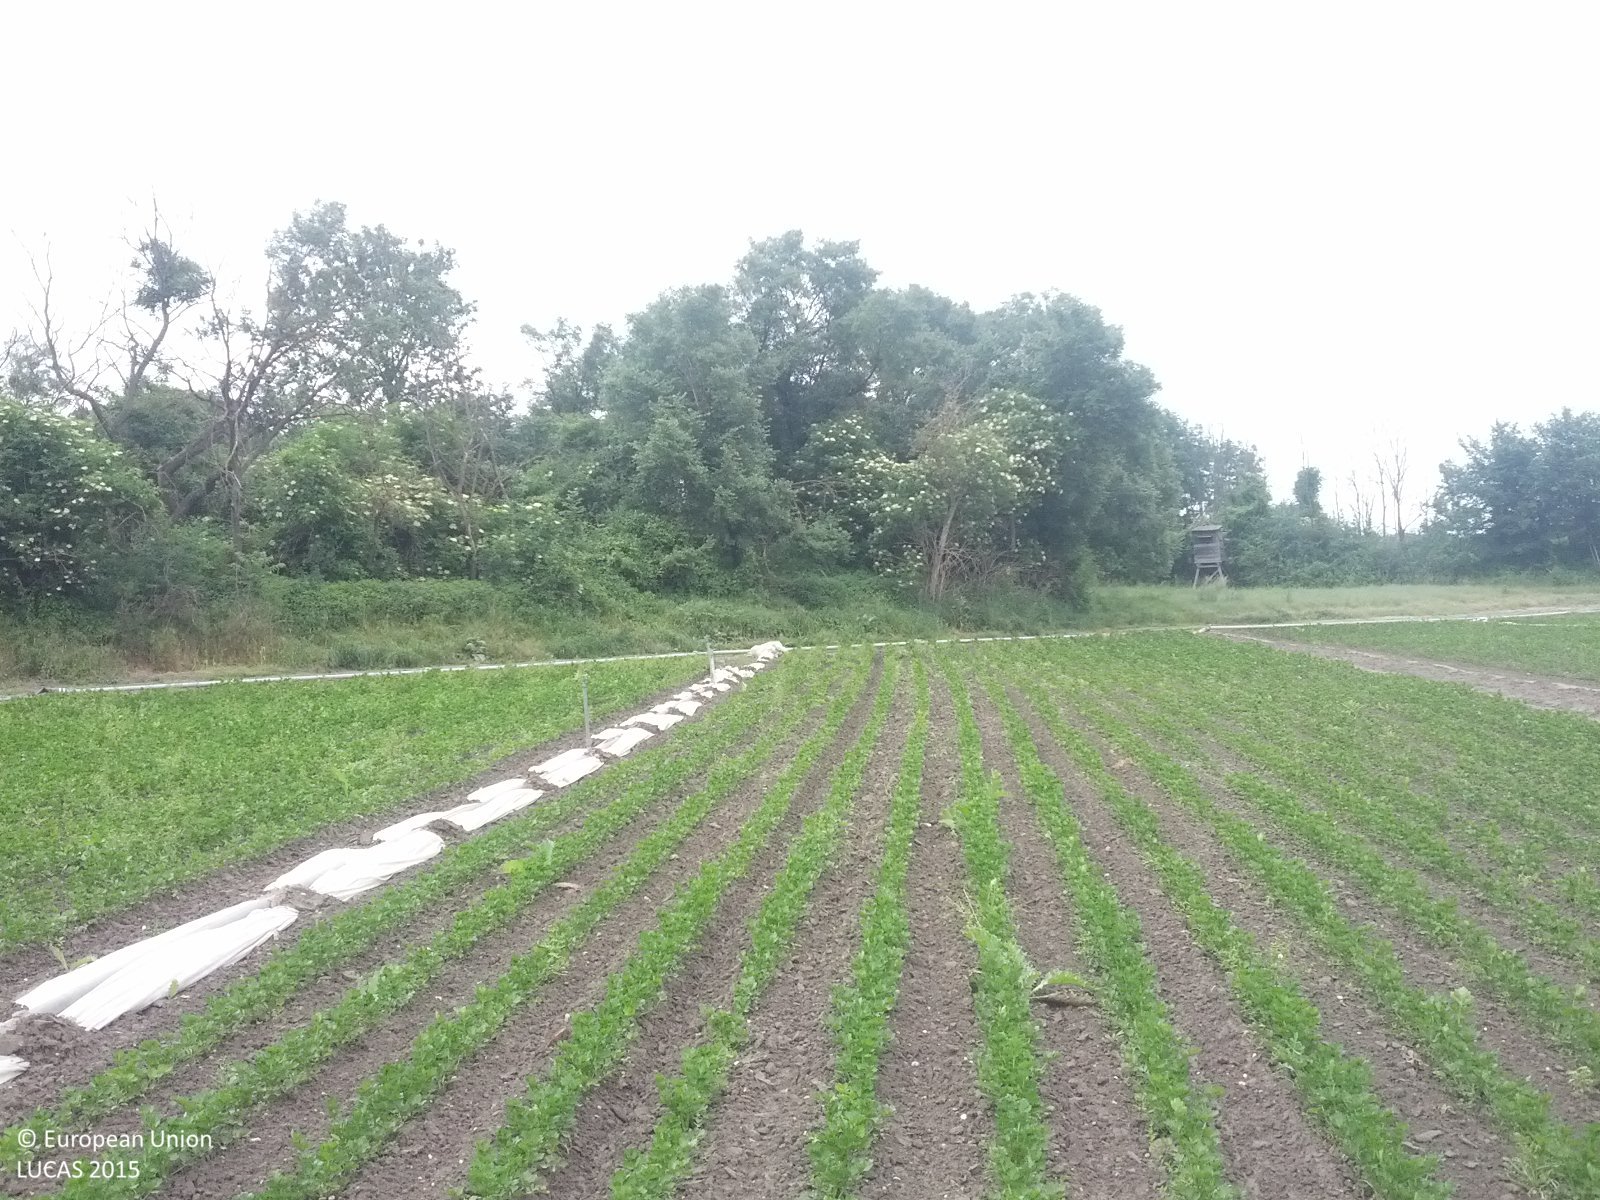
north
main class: Cropland
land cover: Other fresh vegetables
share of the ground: 25 - 50 %
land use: Agriculture (excluding fallow land and kitchen gardens)
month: May
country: AT
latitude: 48.1940
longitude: 16.5033
